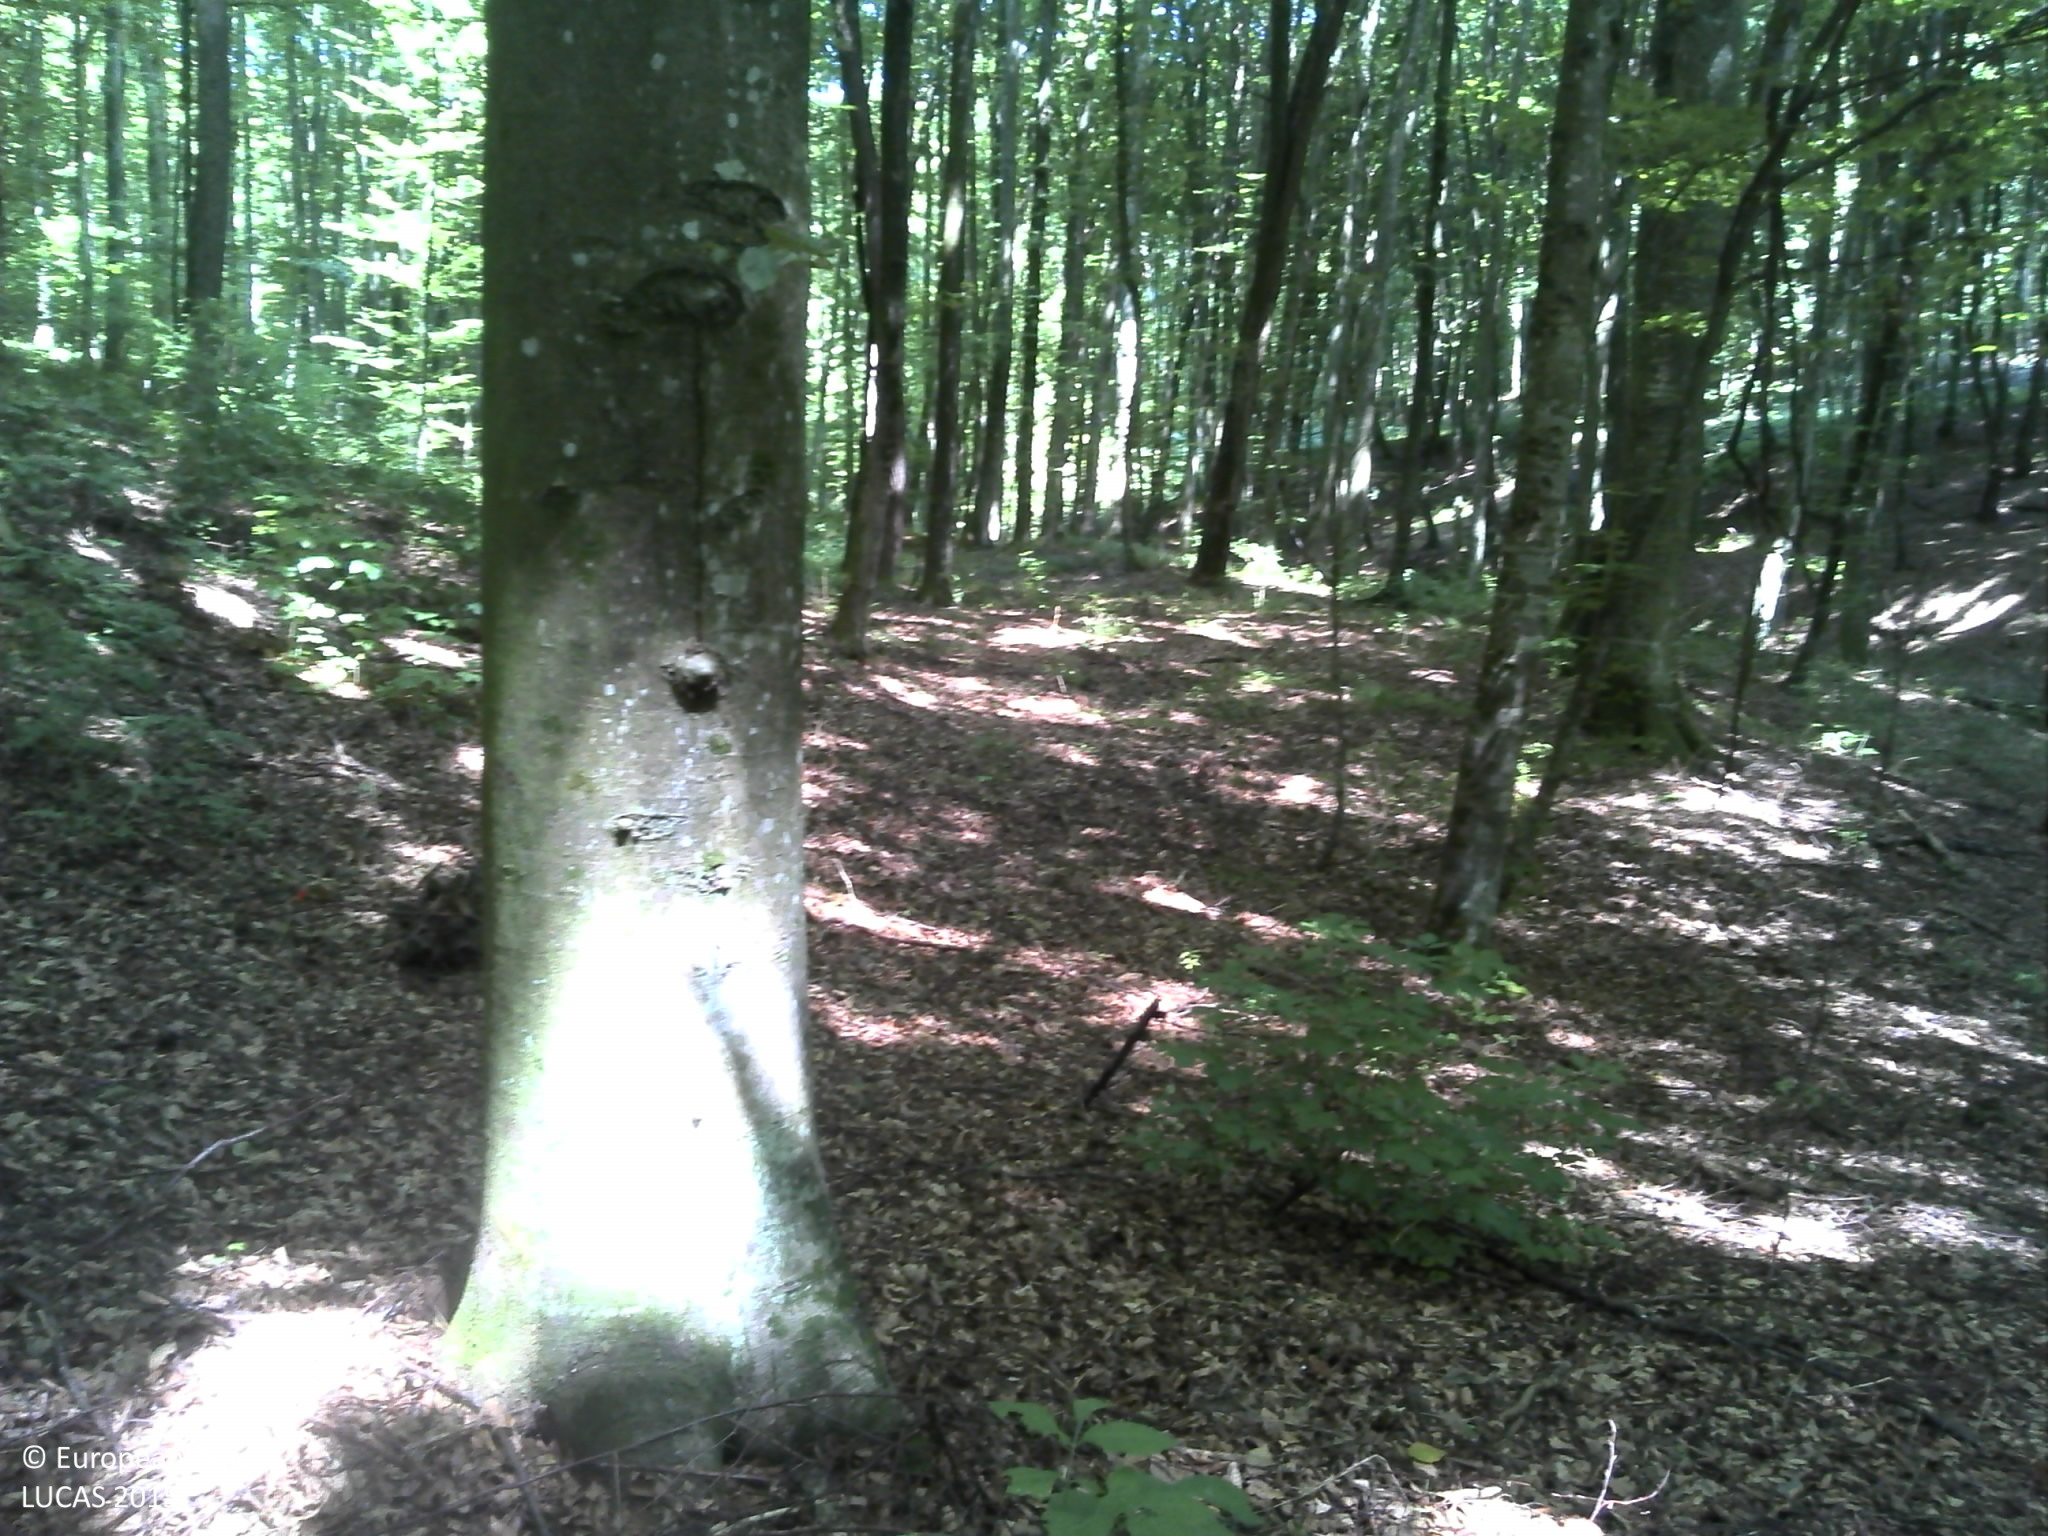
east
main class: Woodland
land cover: Broadleaved woodland
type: acidophilous oak and oak-birch forest
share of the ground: > 75 %
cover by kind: broadleaved forest trees 90 %, shrubs 5 %, herbaceous plants 5 %
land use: Forestry
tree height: > 5 m
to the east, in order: Broadleaved woodland; Rivers and streams; Broadleaved woodland
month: July
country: HR
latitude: 45.5505
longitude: 17.1607
